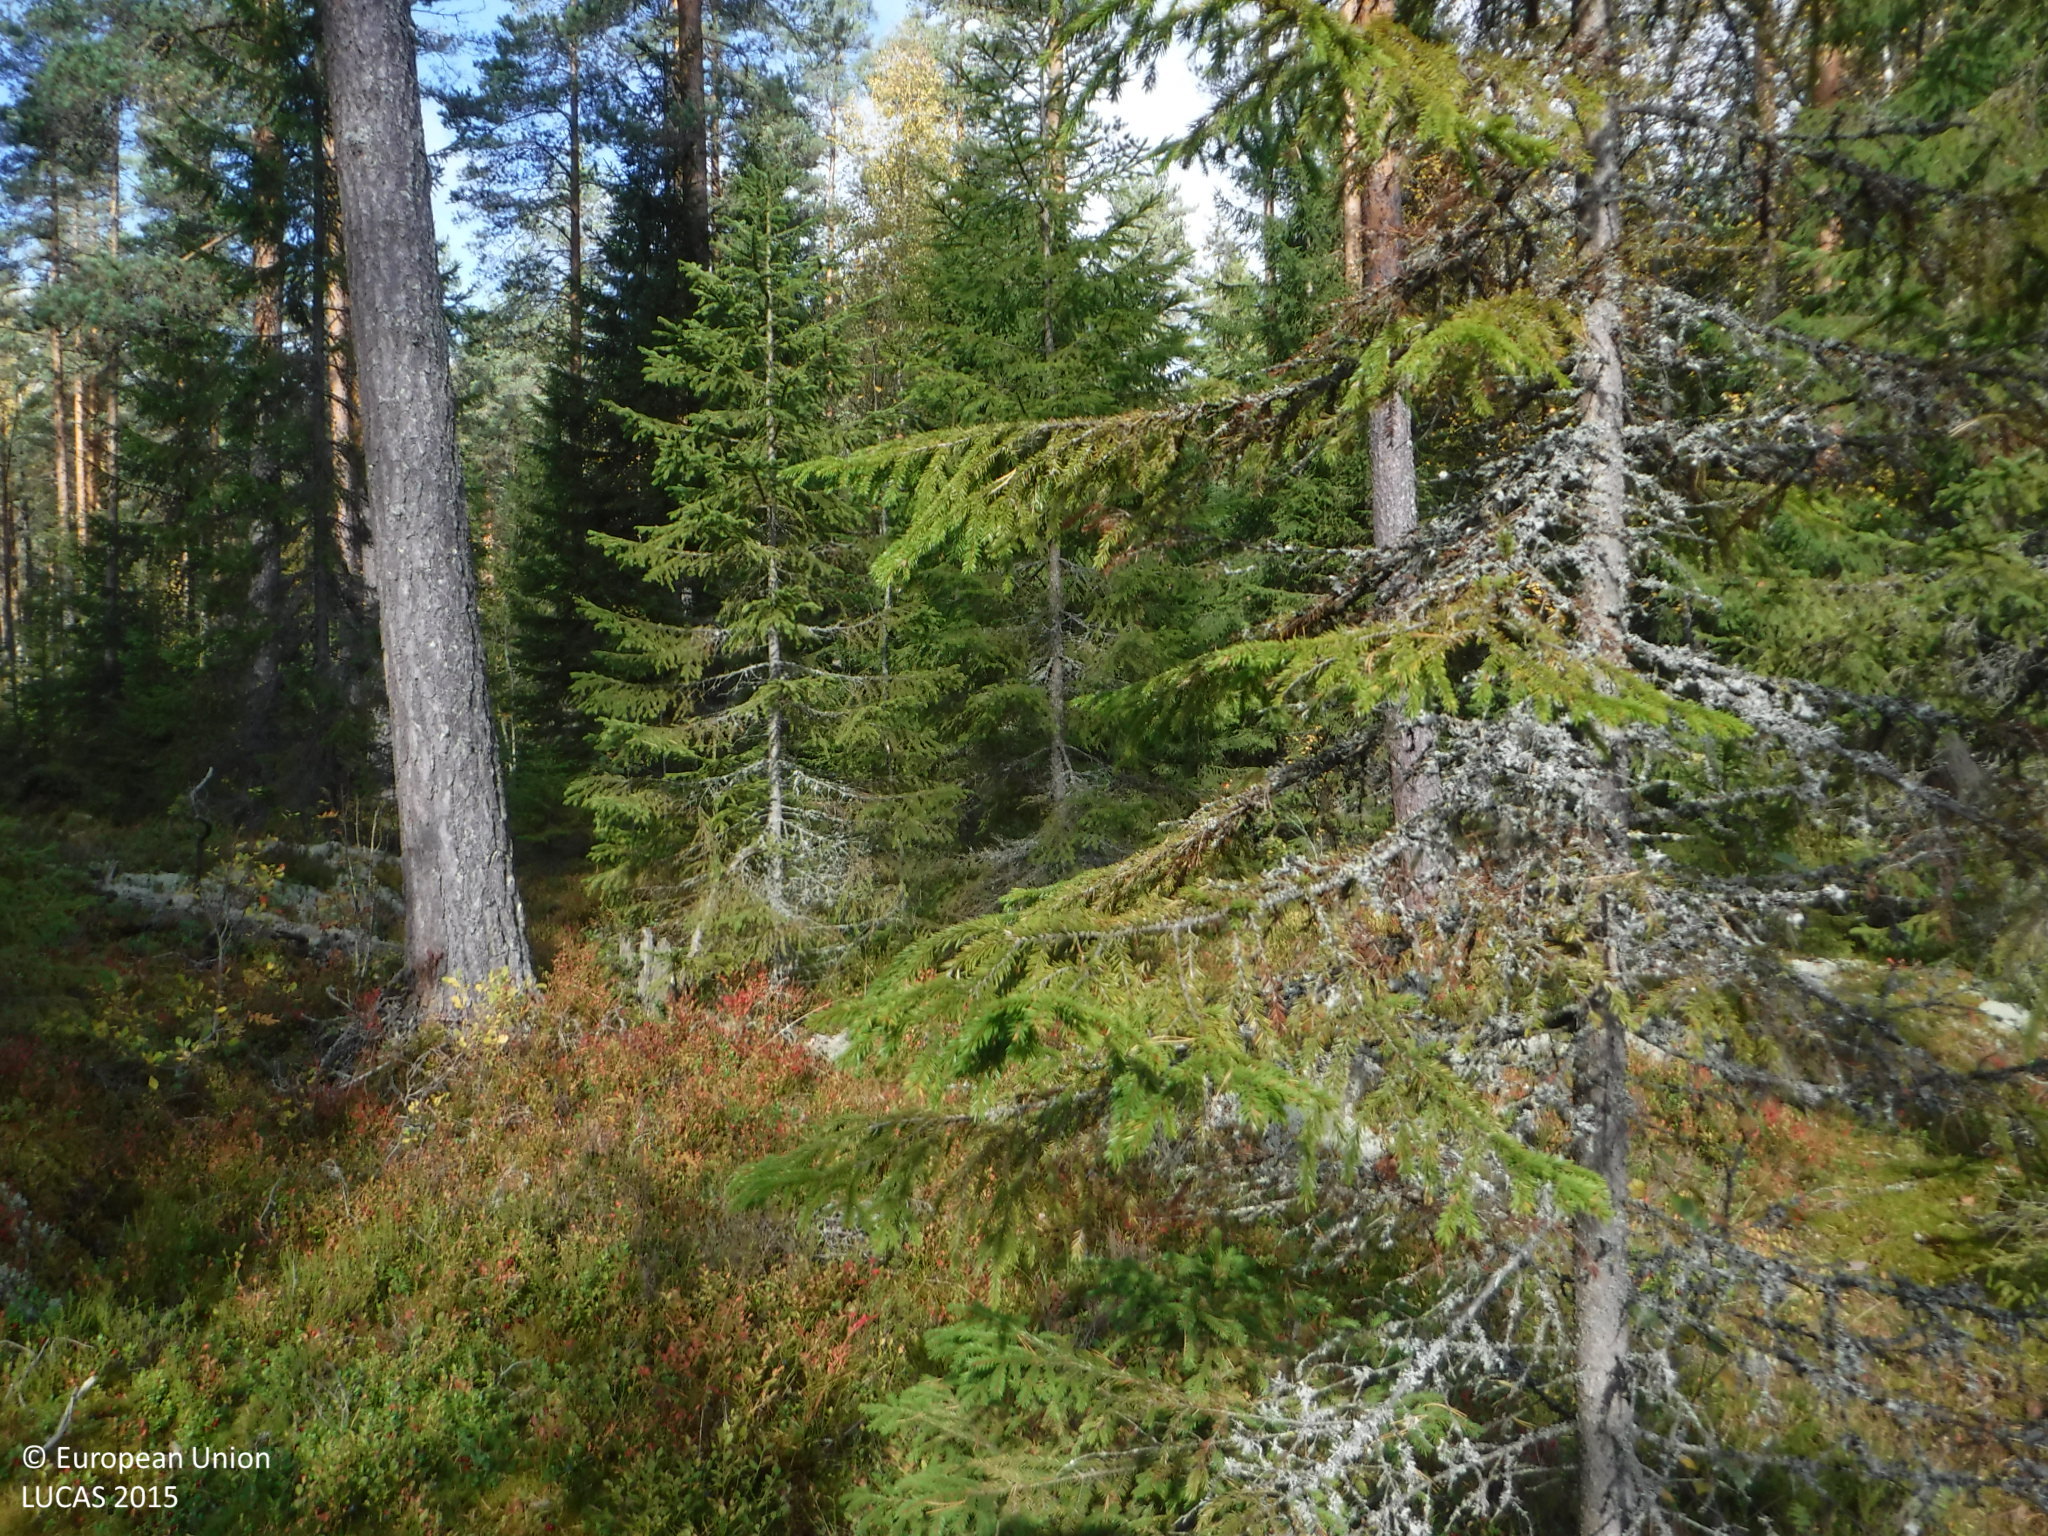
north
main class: Woodland
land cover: Other coniferous woodland
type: boreal forest
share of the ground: 25 - 50 %
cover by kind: shrubs 45 %, coniferous forest trees 30 %, lichens and mosses 25 %
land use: Forestry
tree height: > 5 m
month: September
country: FI
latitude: 61.5926
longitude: 24.1281
